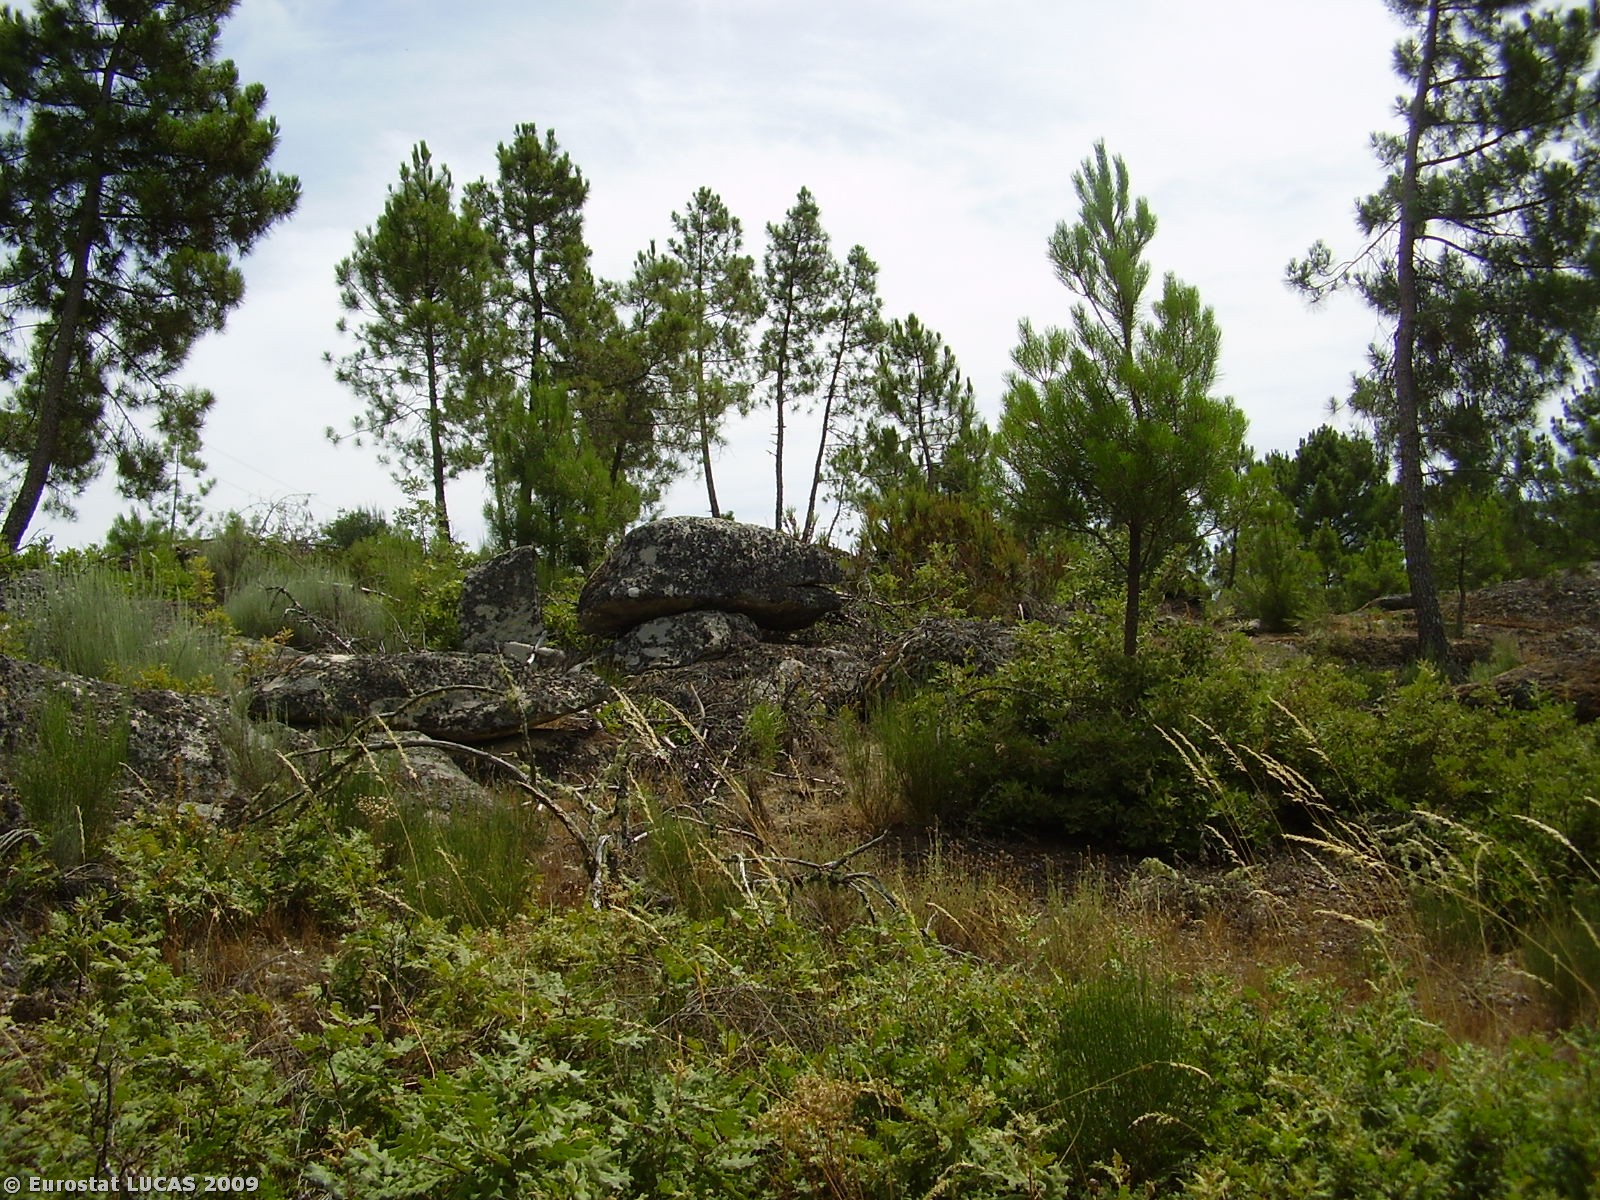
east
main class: Woodland
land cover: Broadleaved woodland
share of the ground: 10 - 25 %
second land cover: Shrubland with sparse tree cover
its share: < 10 %
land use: Unused
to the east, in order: Broadleaved woodland; Shrubland with sparse tree cover; Broadleaved woodland; Shrubland without tree cover; Tracks; Spontaneously vegetated surfaces; Electric lines; Spontaneously vegetated surfaces; Mixed cereals for fodder; Nuts trees; Shrubland with sparse tree cover; Broadleaved woodland
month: July
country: PT
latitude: 41.3749
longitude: -7.4980
